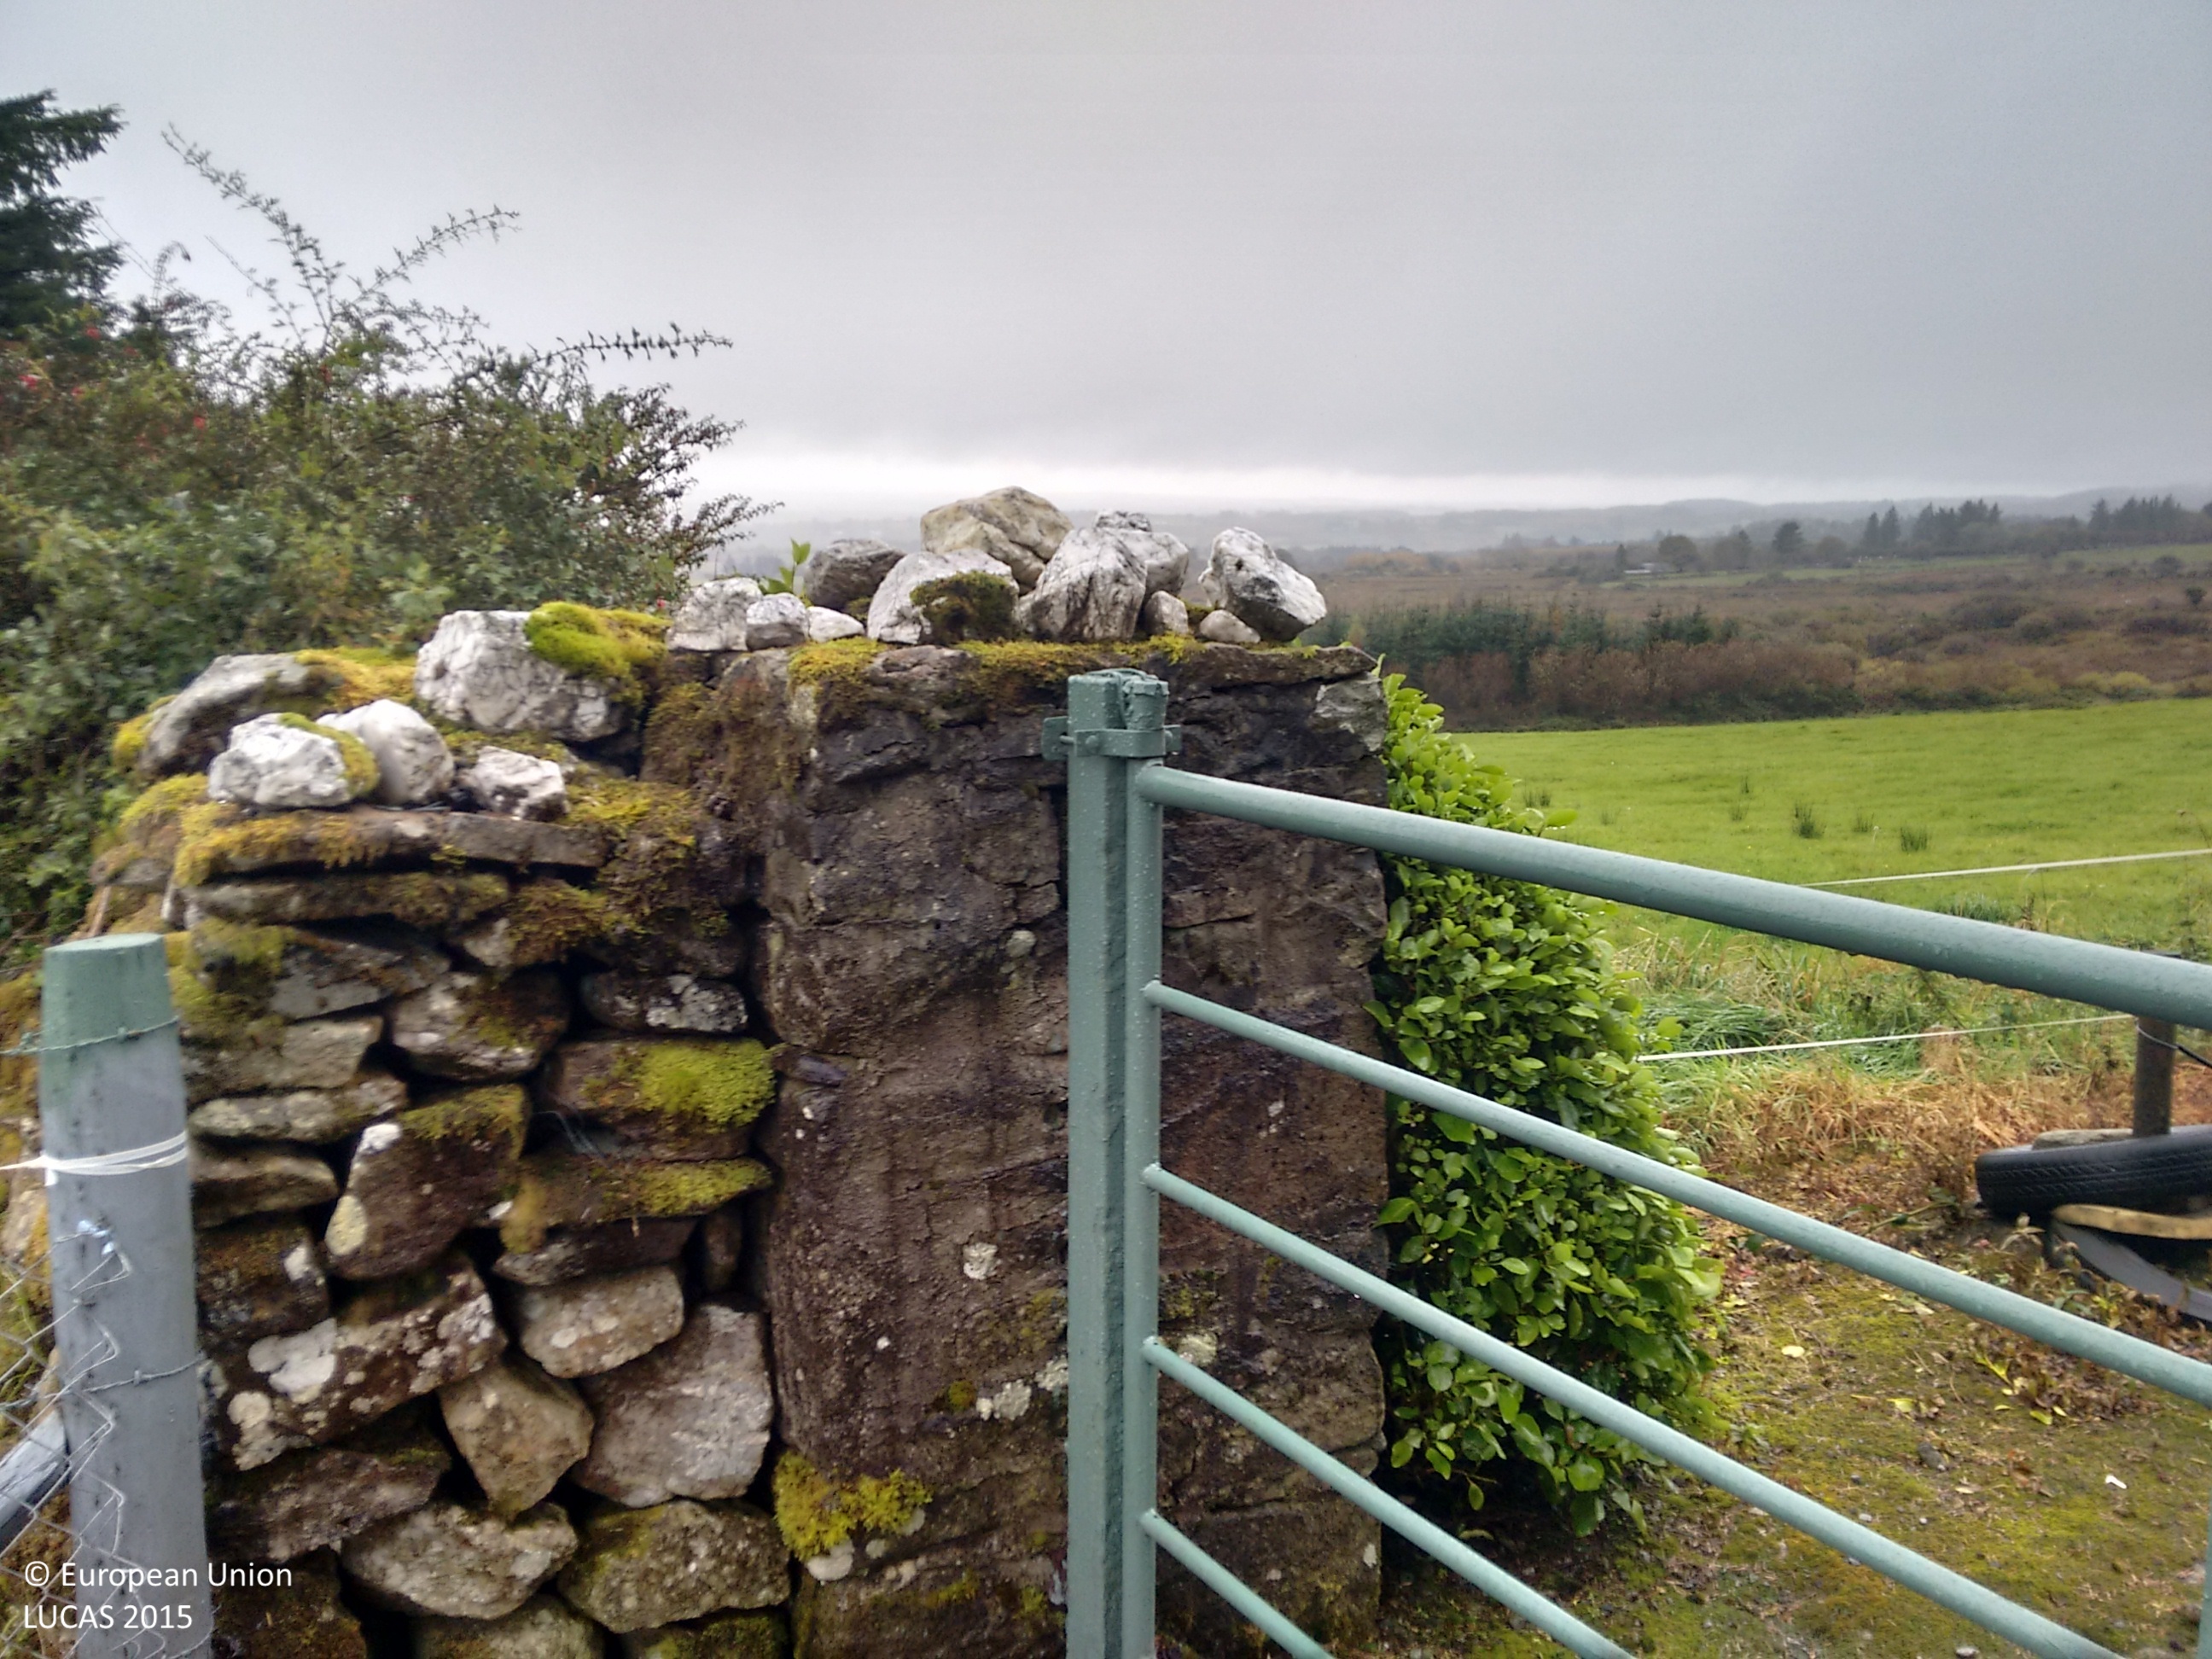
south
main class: Grassland
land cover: Grassland without tree/shrub cover
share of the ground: > 75 %
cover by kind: herbaceous plants 100 %
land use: Agriculture (excluding fallow land and kitchen gardens)
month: October
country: IE
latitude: 54.0551
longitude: -8.9212
